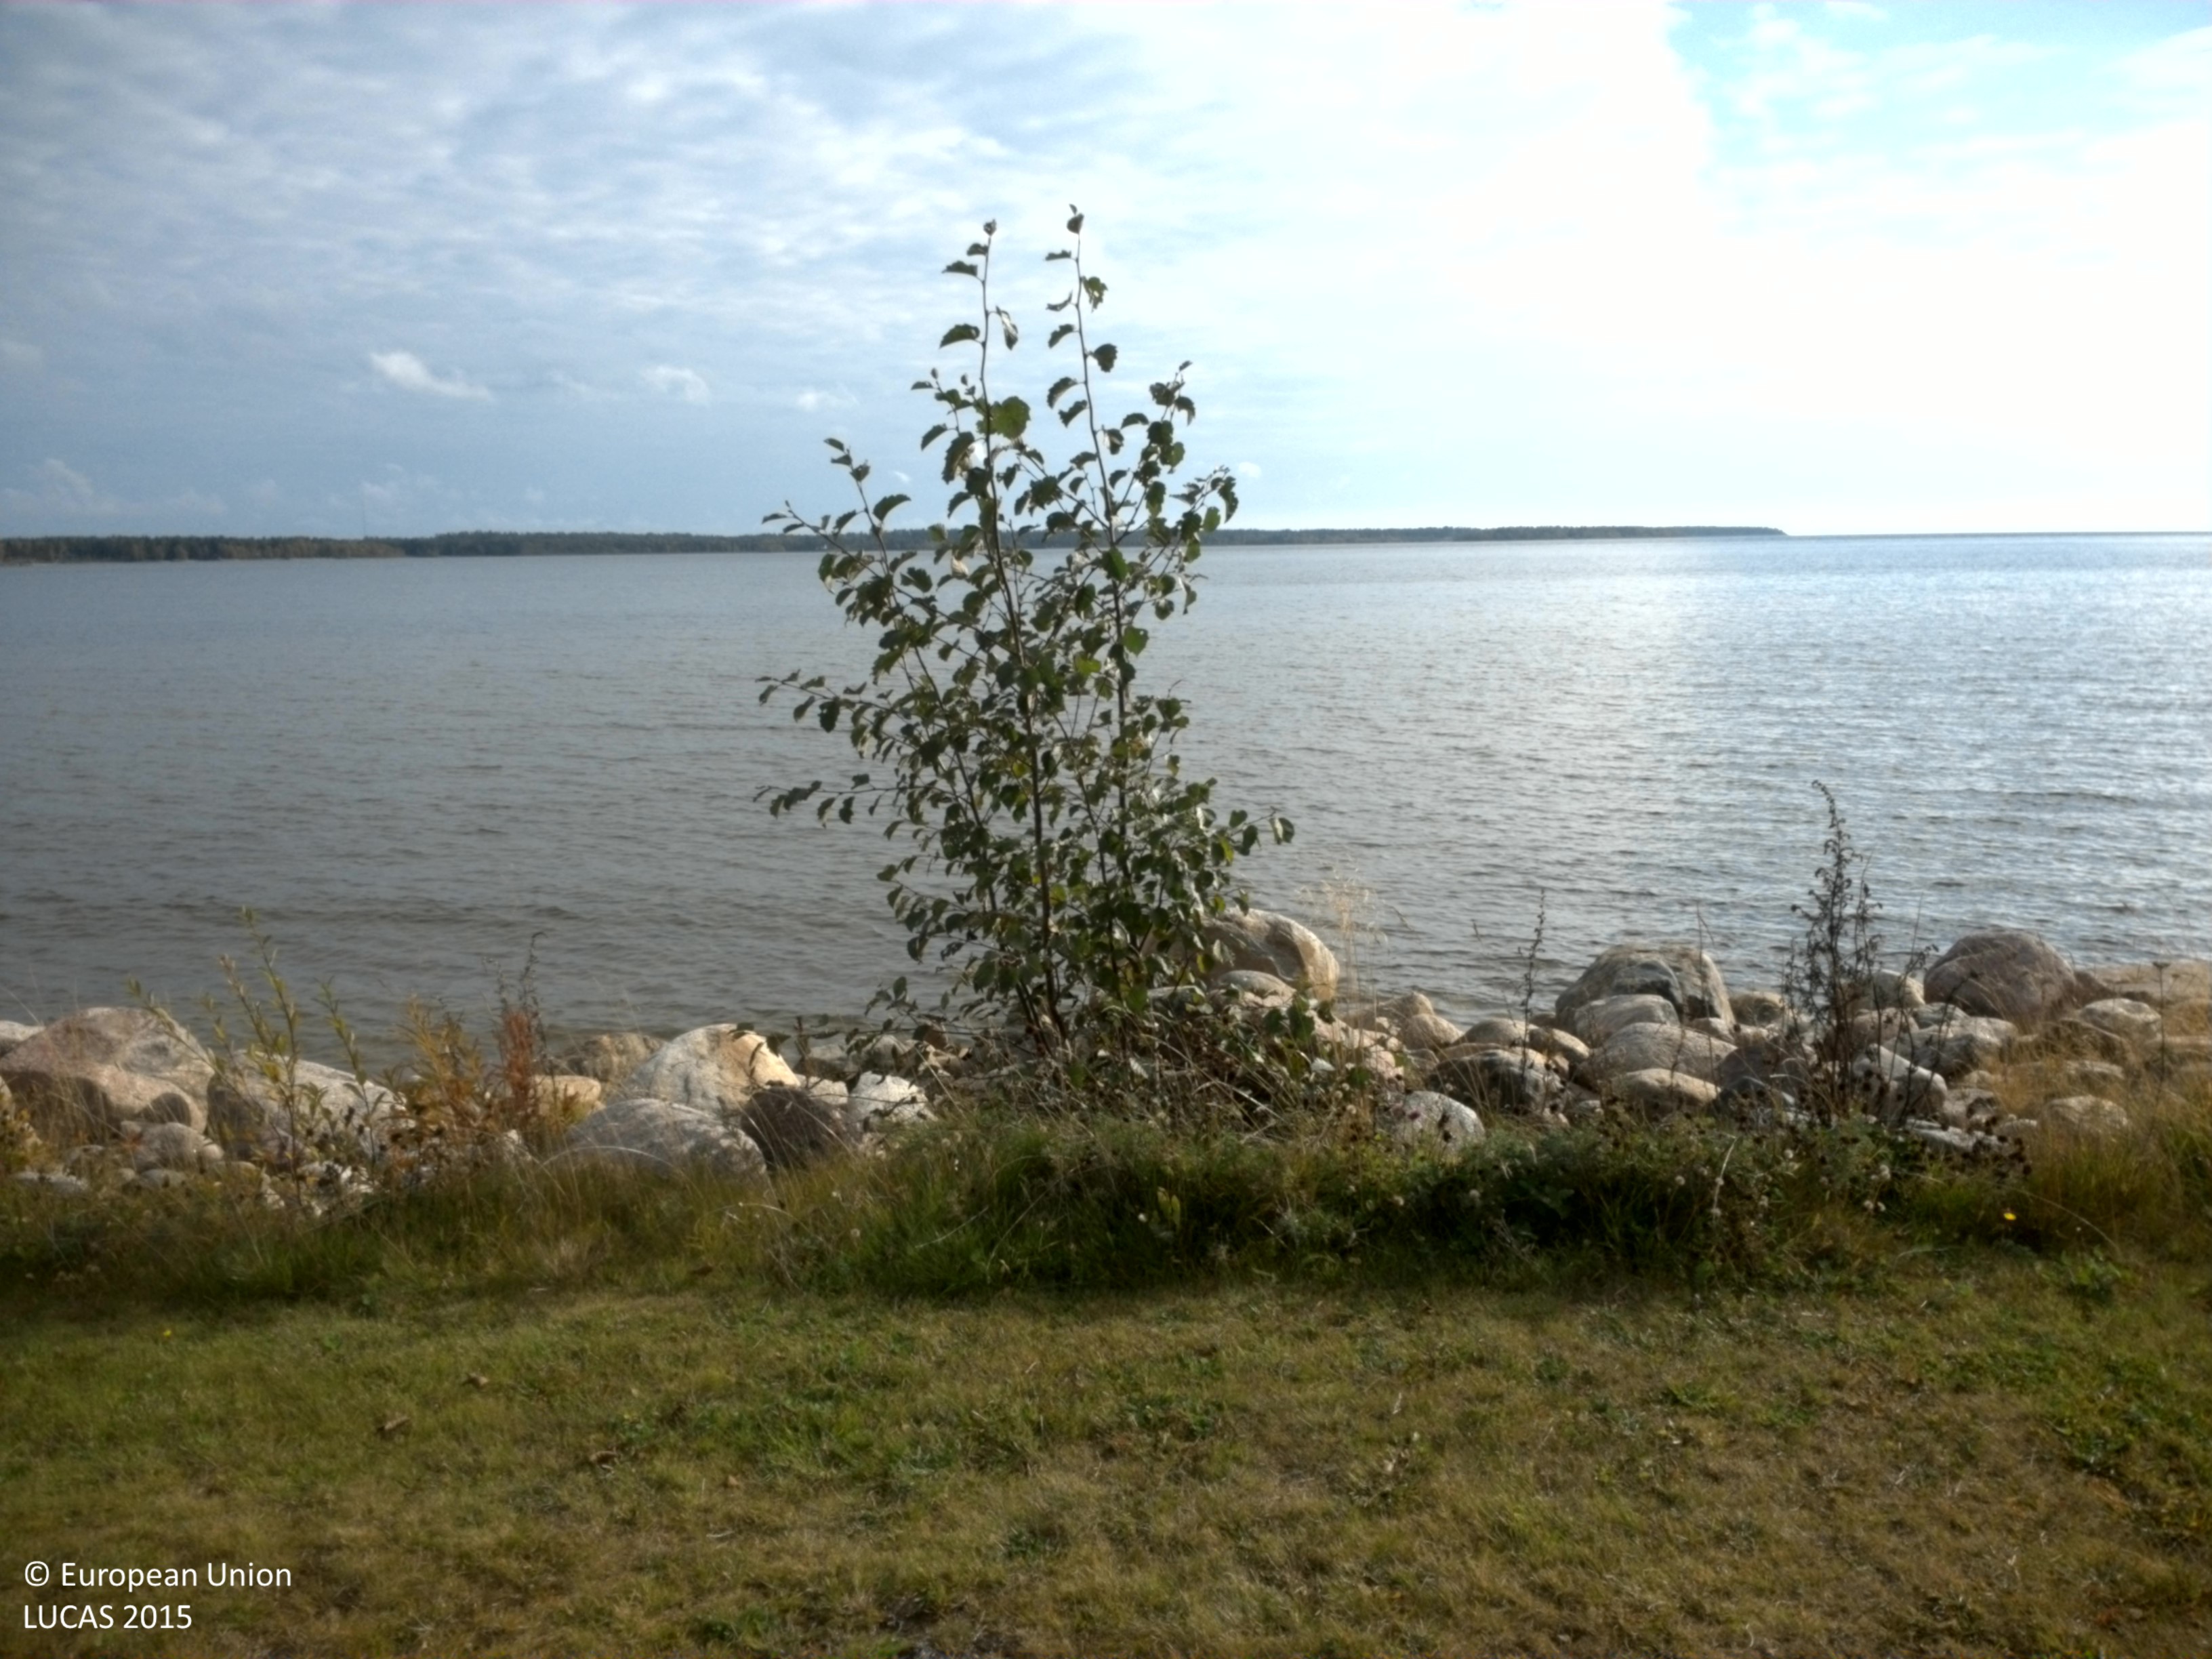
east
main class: Grassland
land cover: Grassland without tree/shrub cover
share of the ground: > 75 %
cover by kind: herbaceous plants 100 %
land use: Residential
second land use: Amenities, museums, leisure
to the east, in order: Grassland without tree/shrub cover; Rocks and stones
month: September
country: SE
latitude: 65.4325
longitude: 21.8991
